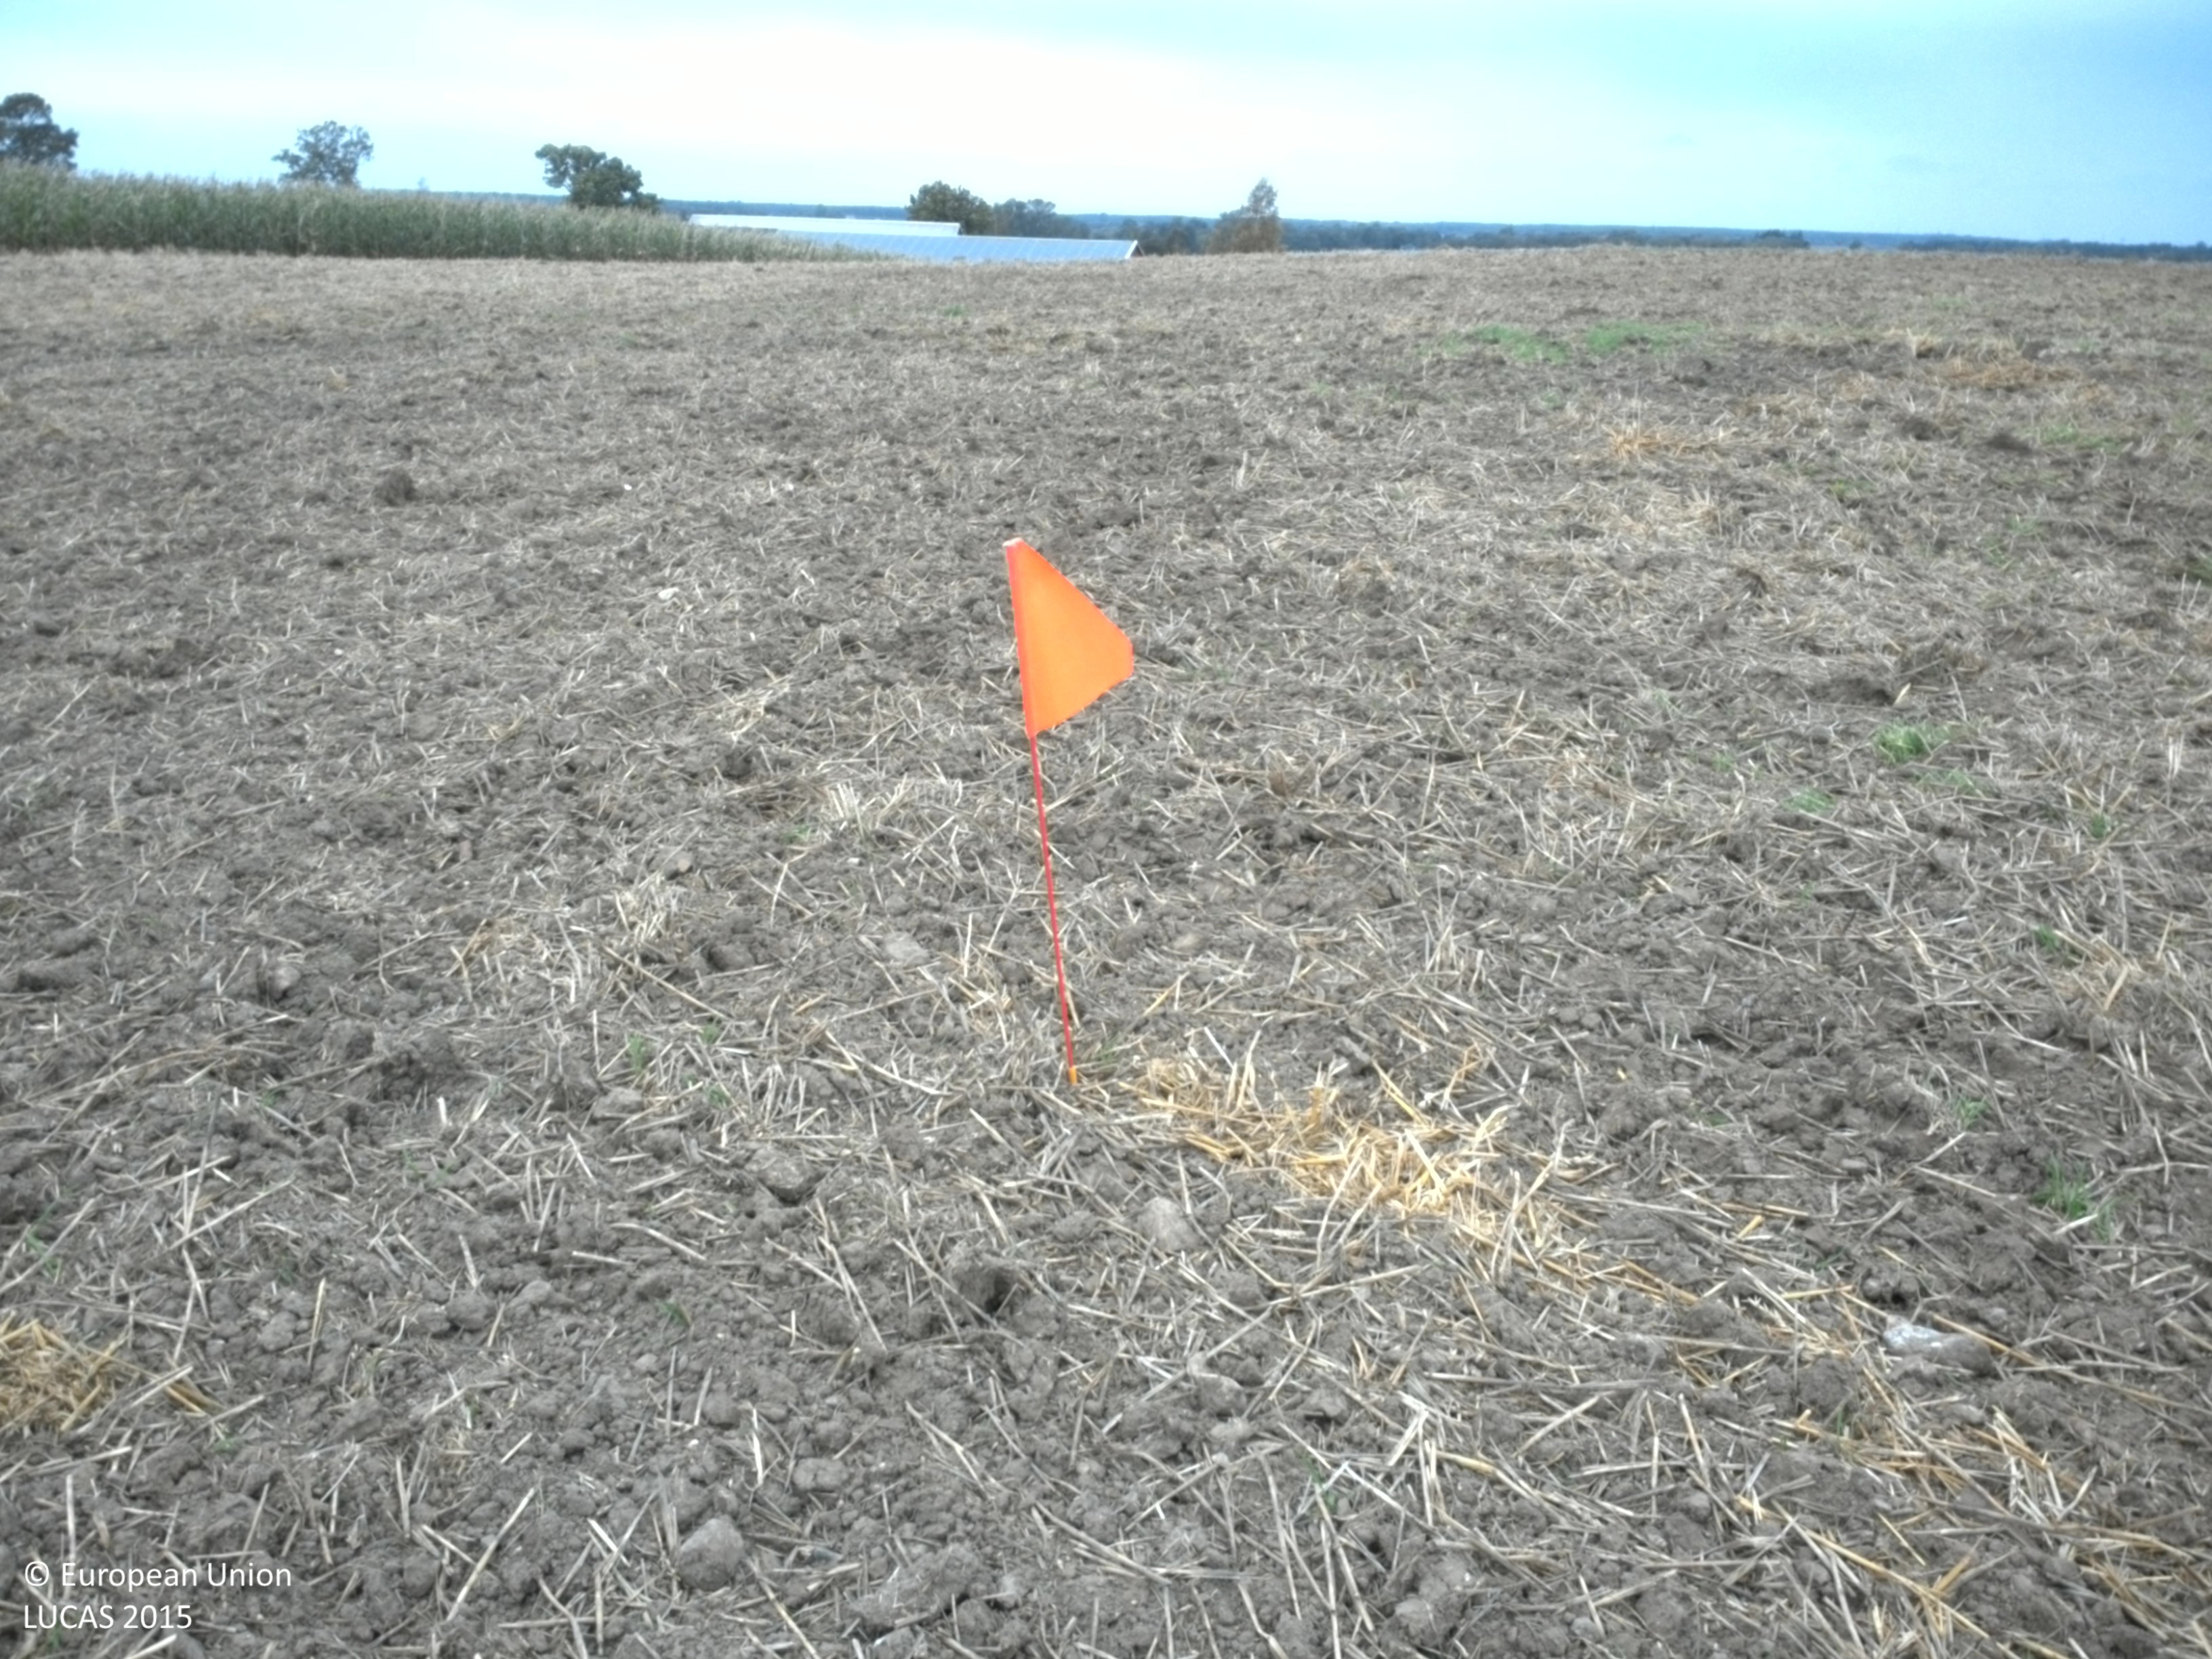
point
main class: Cropland
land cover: Common wheat
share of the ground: < 10 %
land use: Agriculture (excluding fallow land and kitchen gardens)
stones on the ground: < 10 %
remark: Harvested field
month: October
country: SE
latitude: 55.8278
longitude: 13.0469
